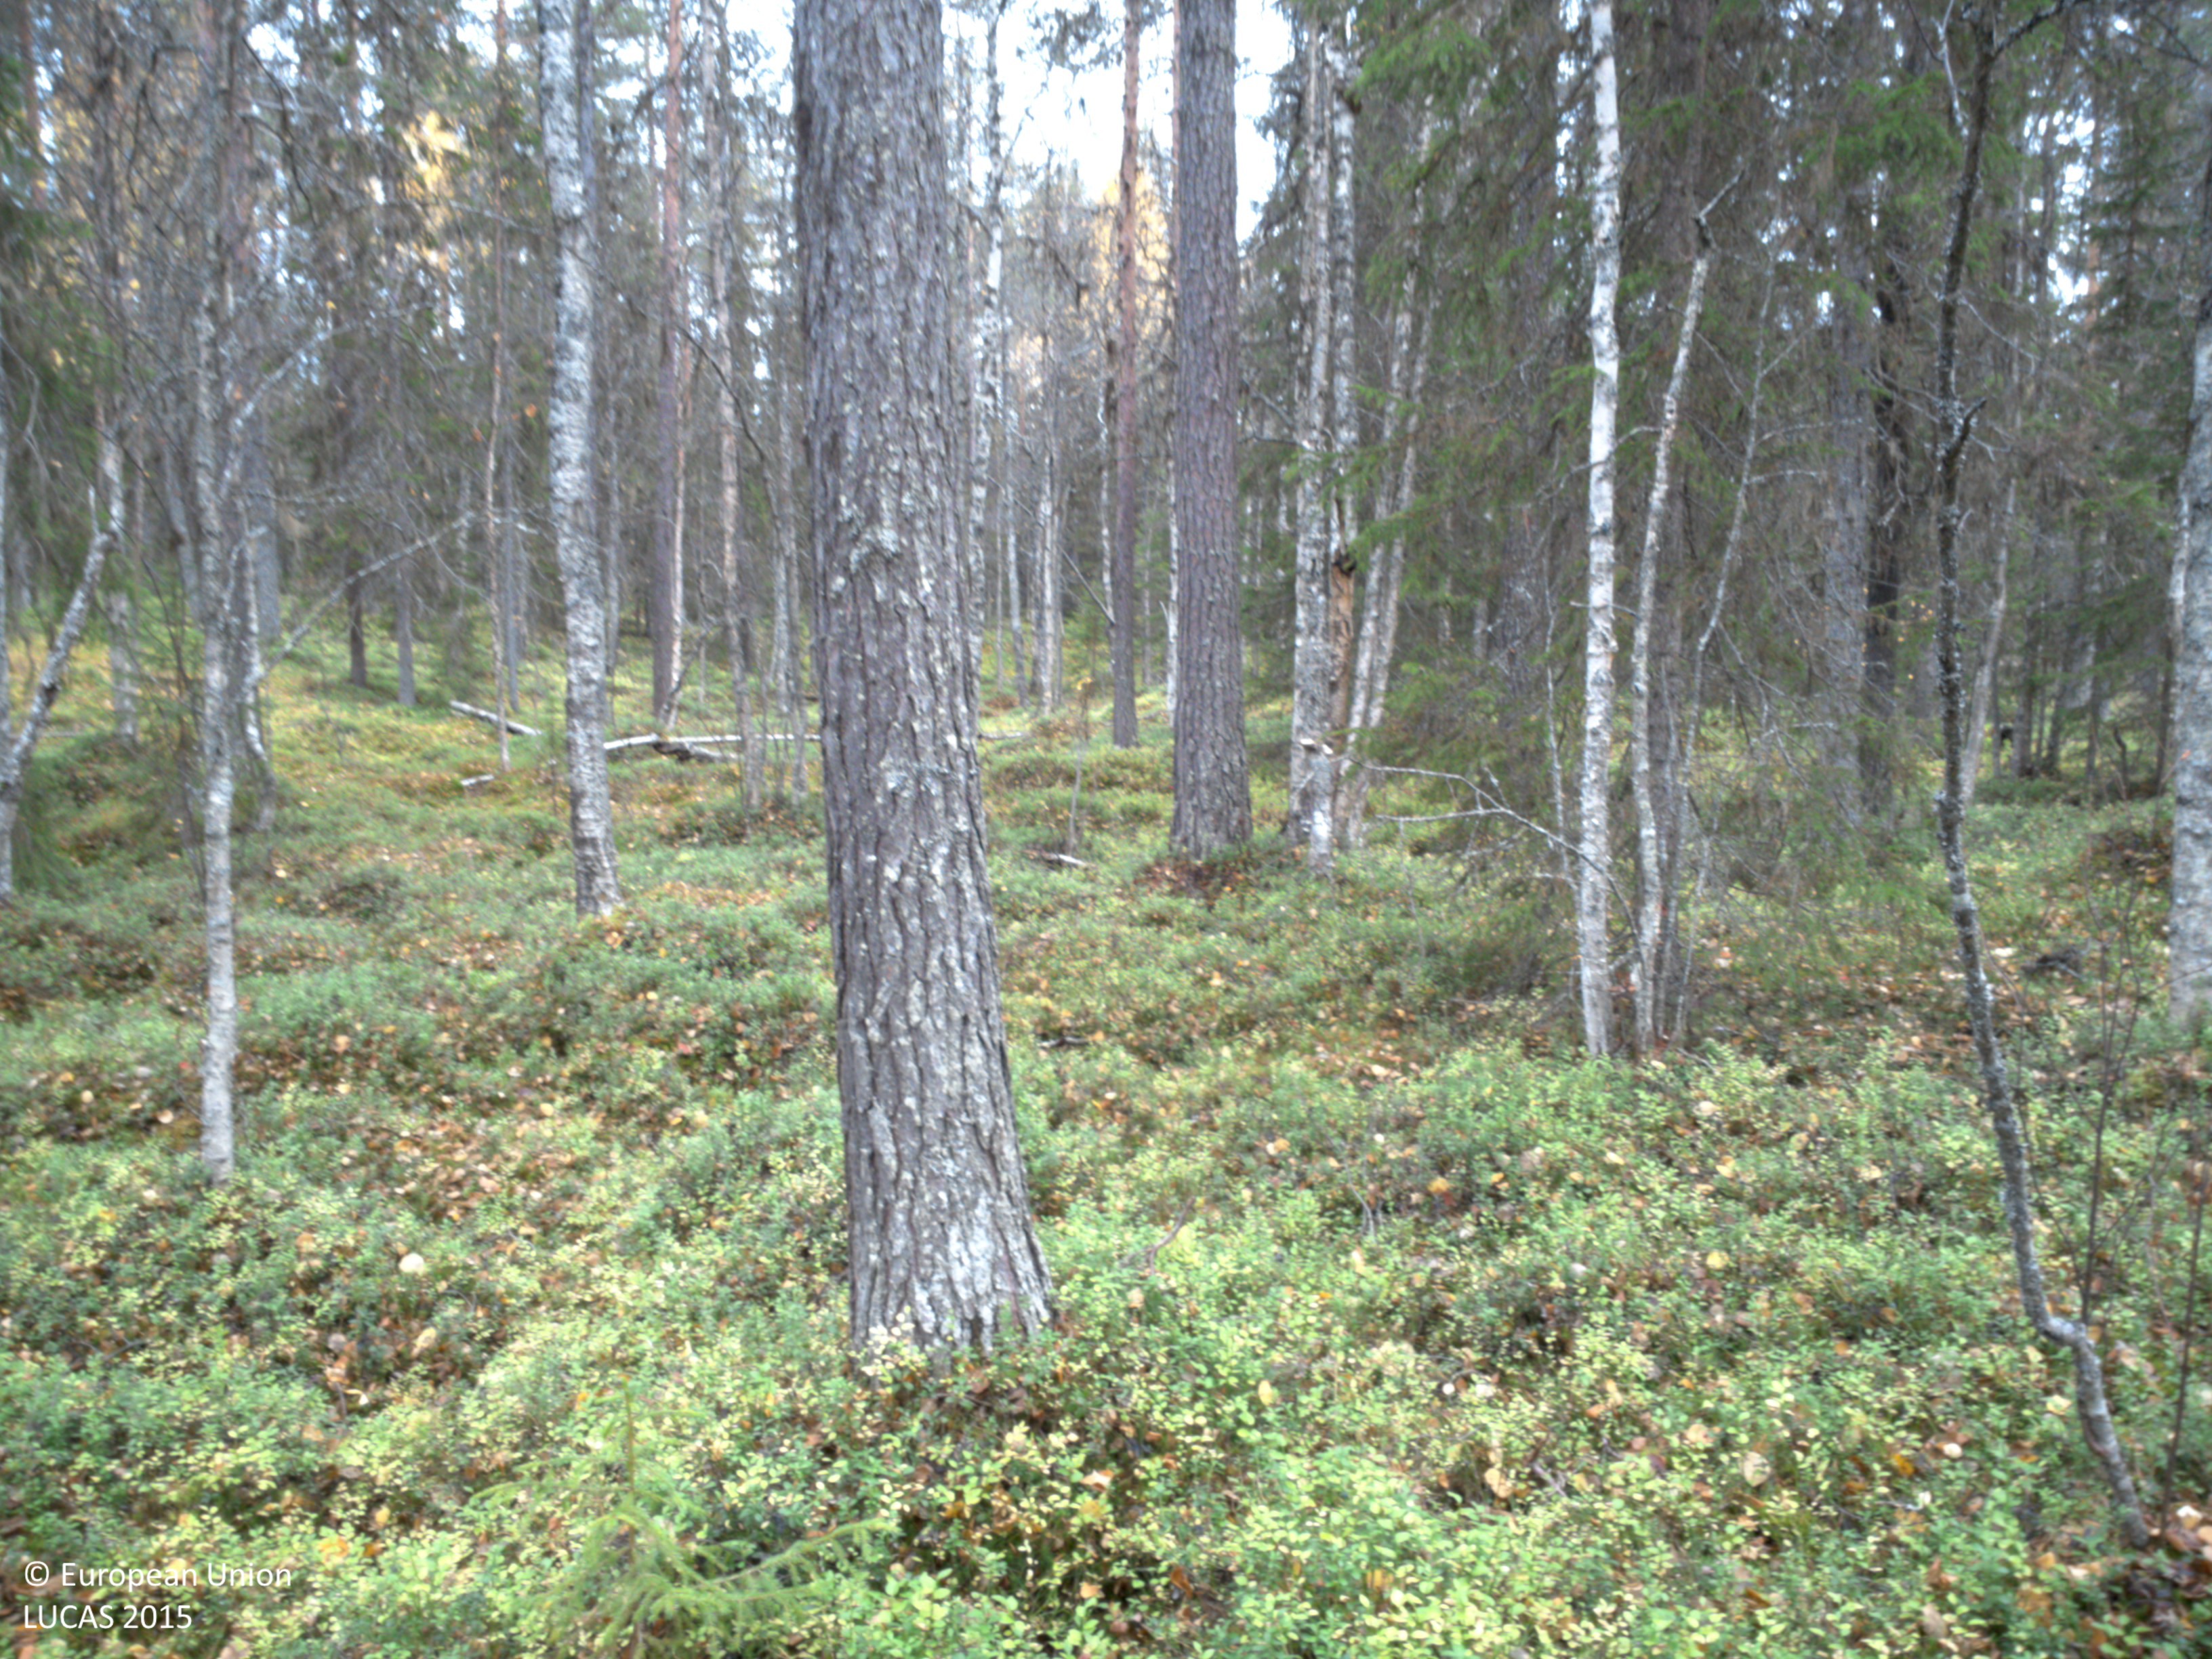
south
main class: Woodland
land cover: Pine dominated mixed woodland
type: boreal forest
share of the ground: 50 - 75 %
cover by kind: coniferous forest trees 50 %, broadleaved forest trees 25 %, shrubs 15 %, lichens and mosses 10 %
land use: Forestry
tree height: > 5 m
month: October
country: SE
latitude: 64.7882
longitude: 18.1502
